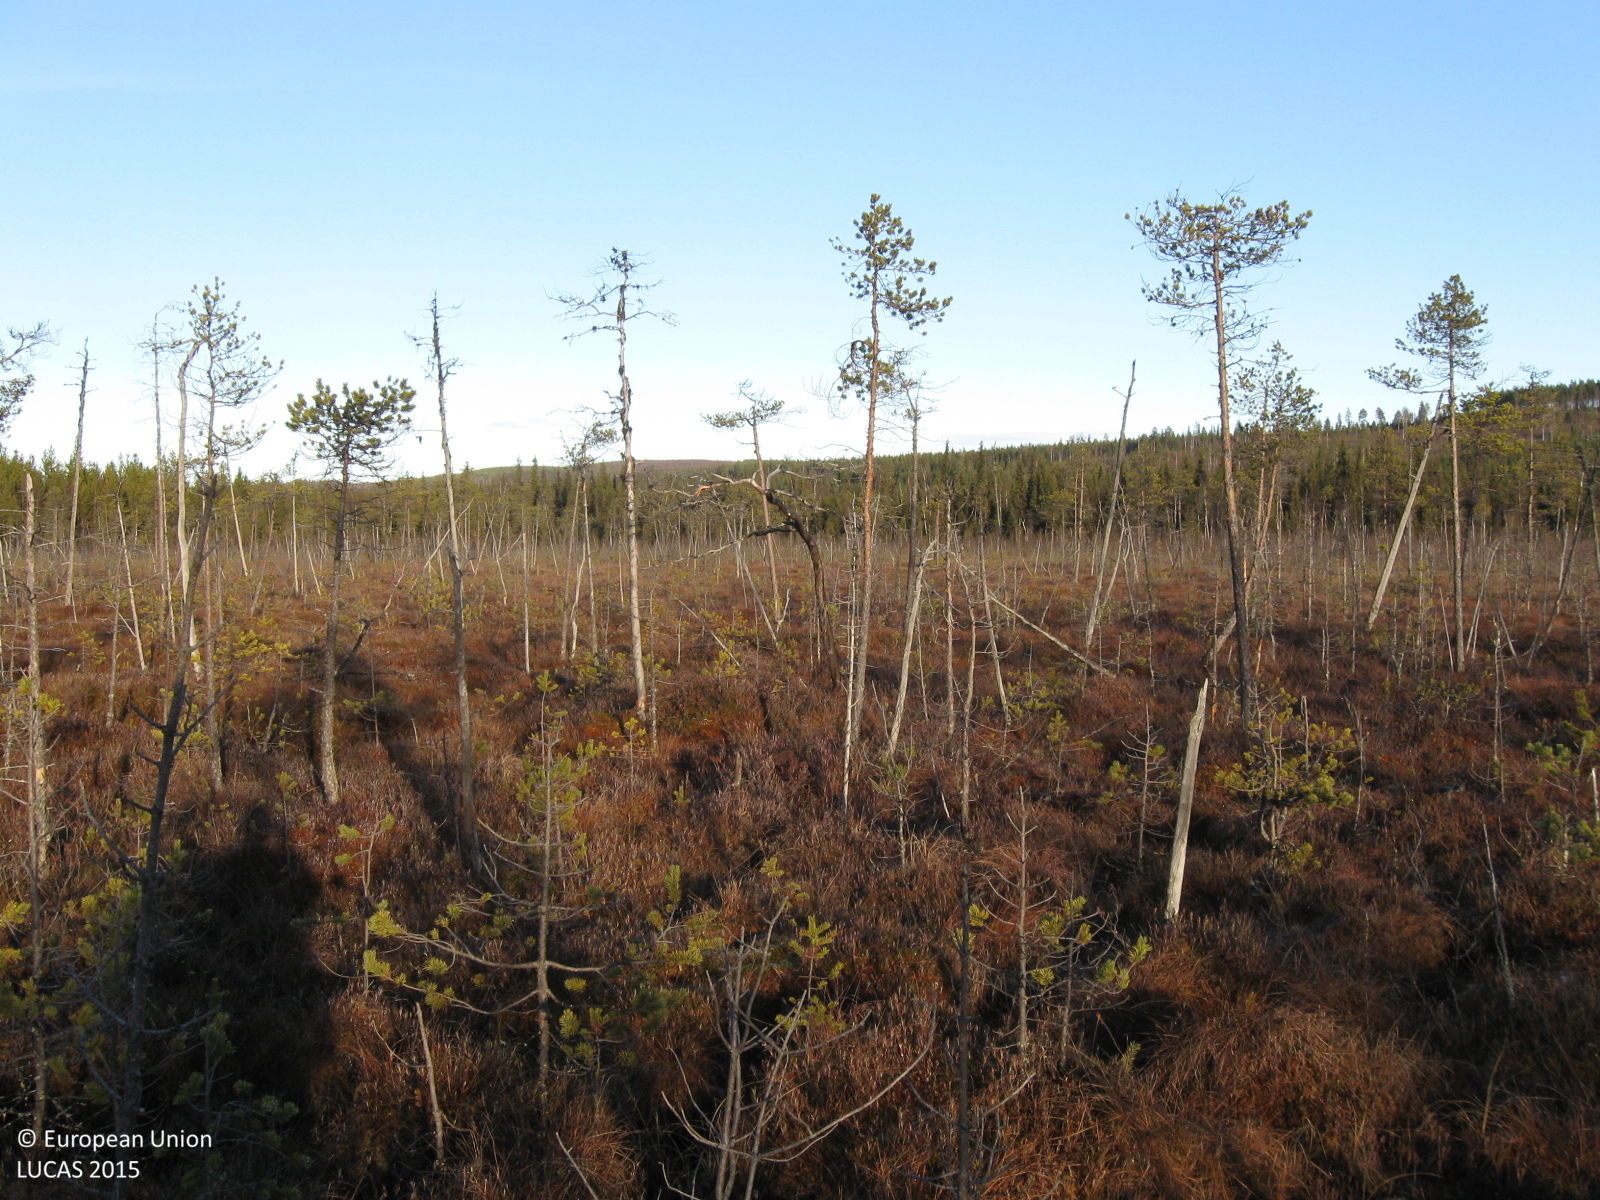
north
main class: Woodland
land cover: Pine dominated coniferous woodland
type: mire and swamp forests
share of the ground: 10 - 25 %
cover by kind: herbaceous plants 55 %, coniferous forest trees 20 %, lichens and mosses 15 %, shrubs 10 %
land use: Semi-natural and natural areas not in use
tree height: < 5 m
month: October
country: SE
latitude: 66.2531
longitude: 20.8879
